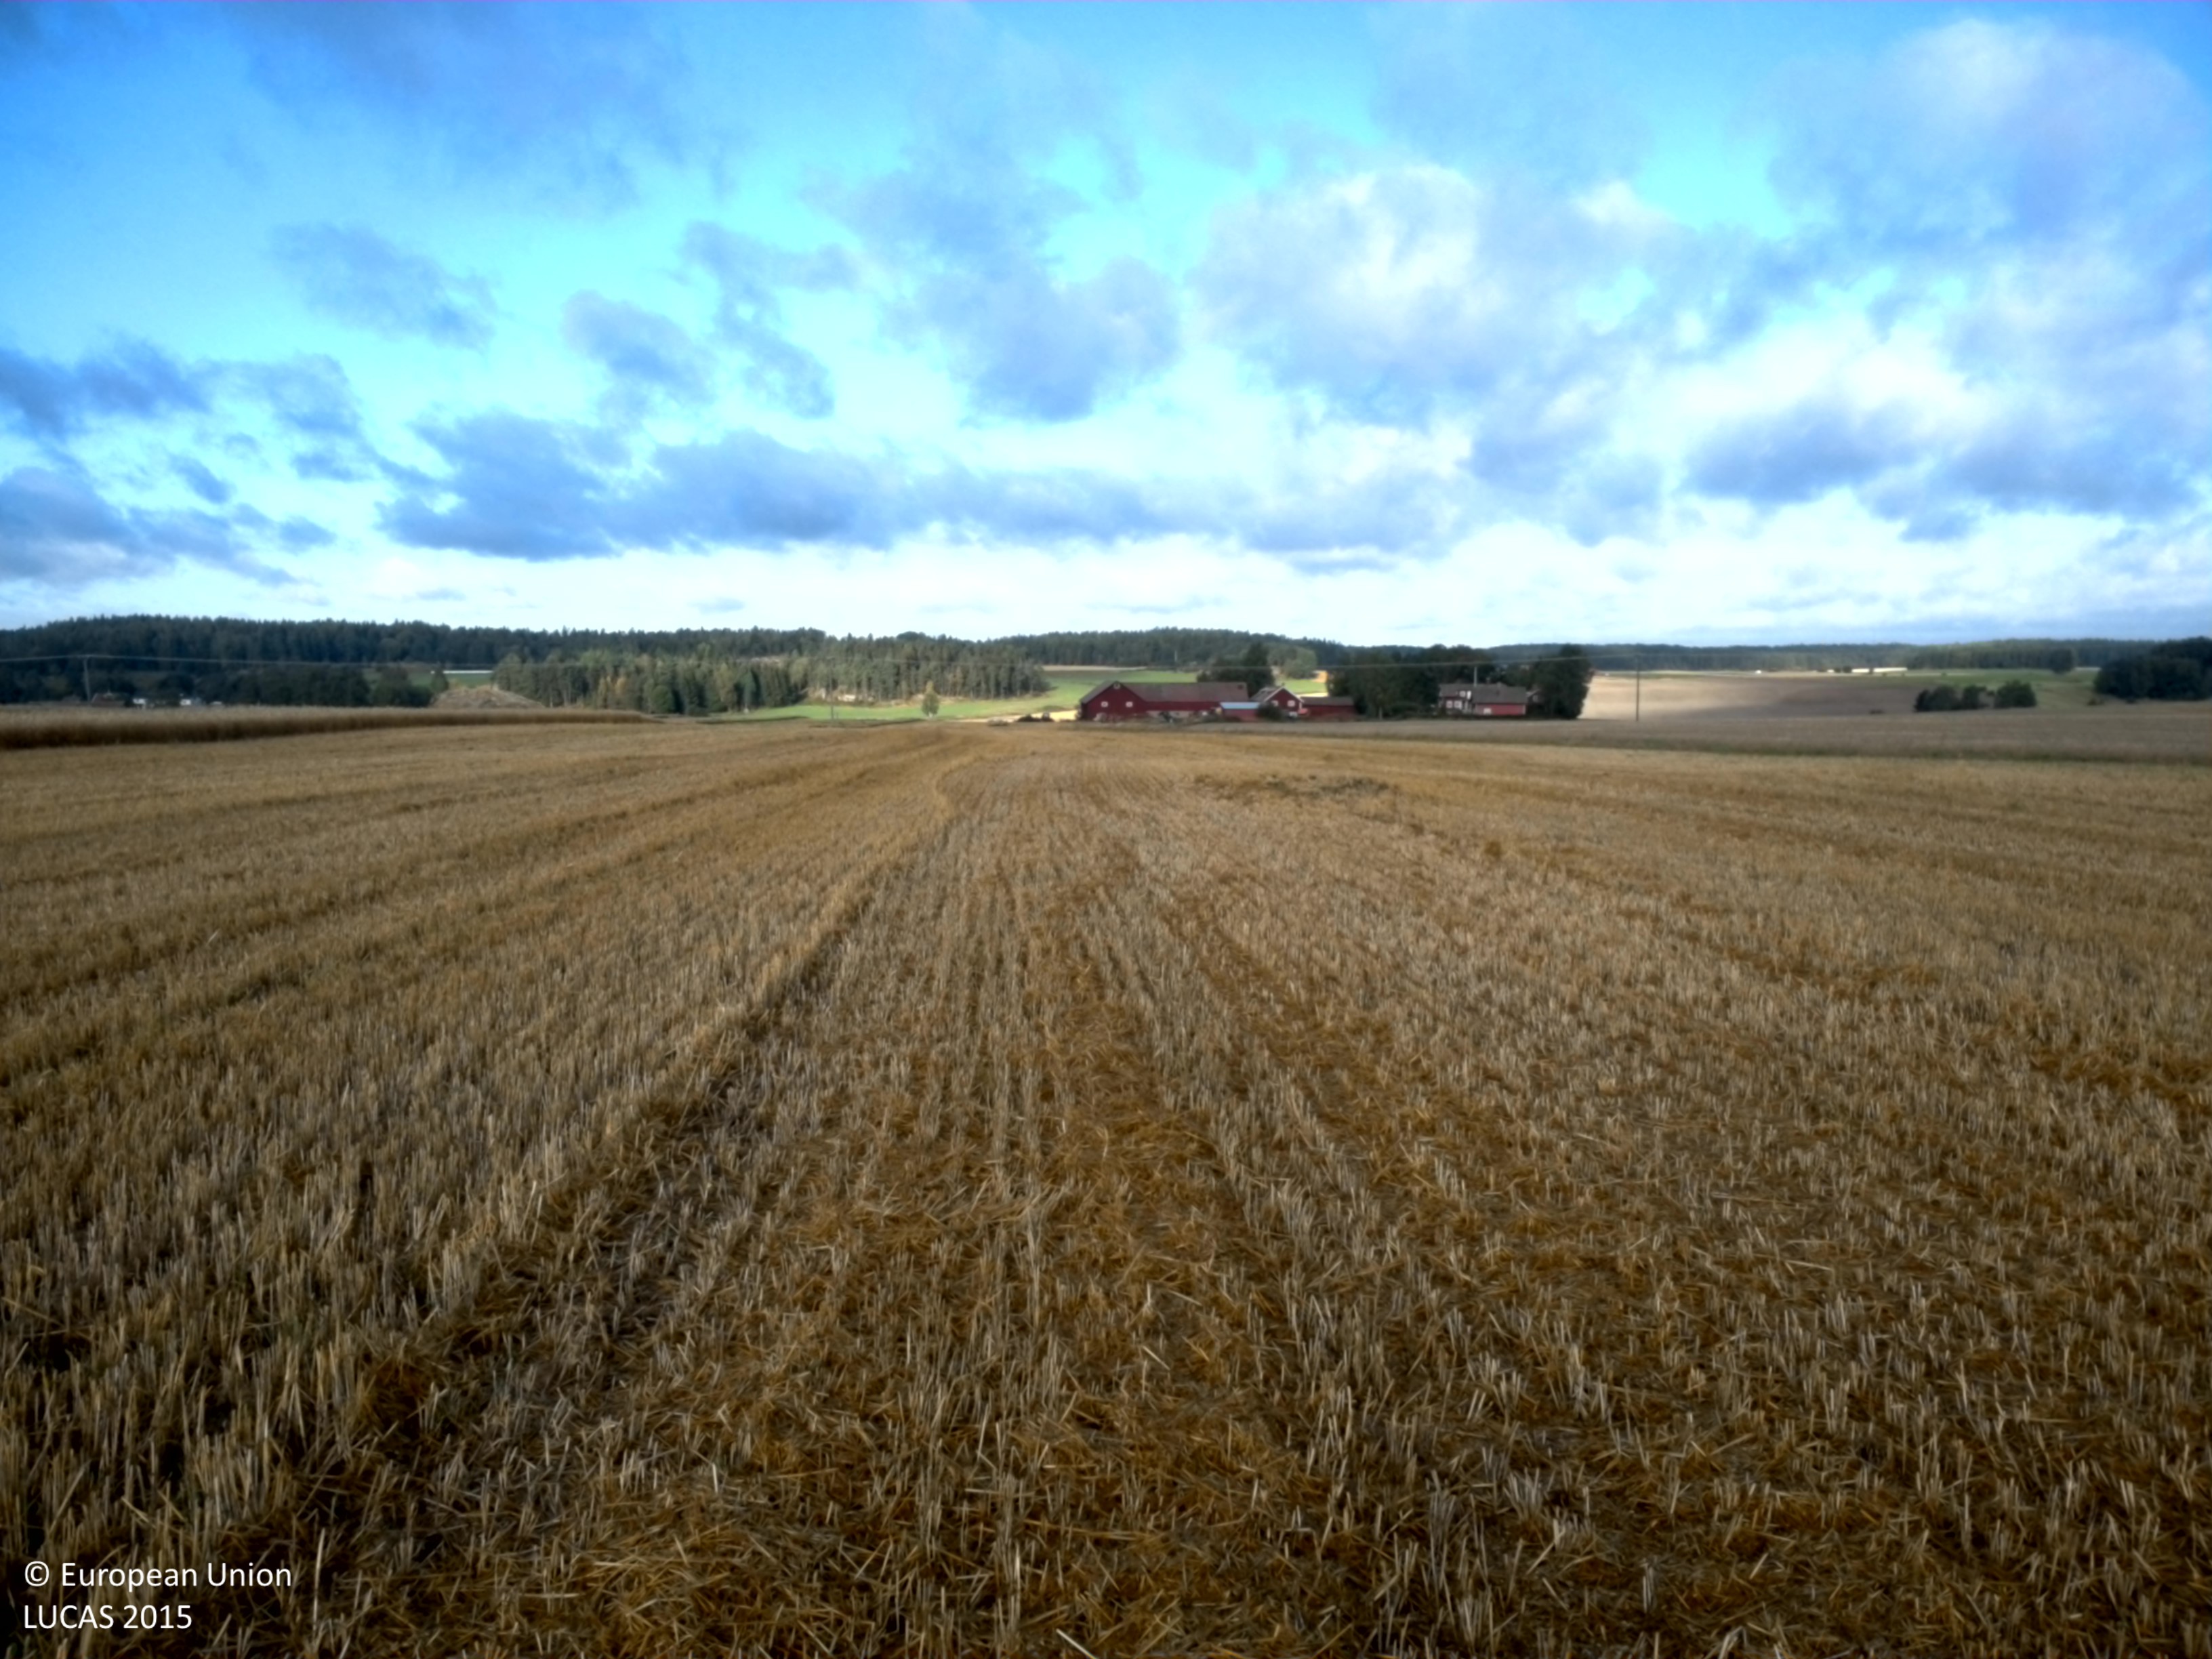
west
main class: Cropland
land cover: Common wheat
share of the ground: < 10 %
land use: Agriculture (excluding fallow land and kitchen gardens)
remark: Harvested field
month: August
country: SE
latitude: 59.7848
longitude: 17.1009
